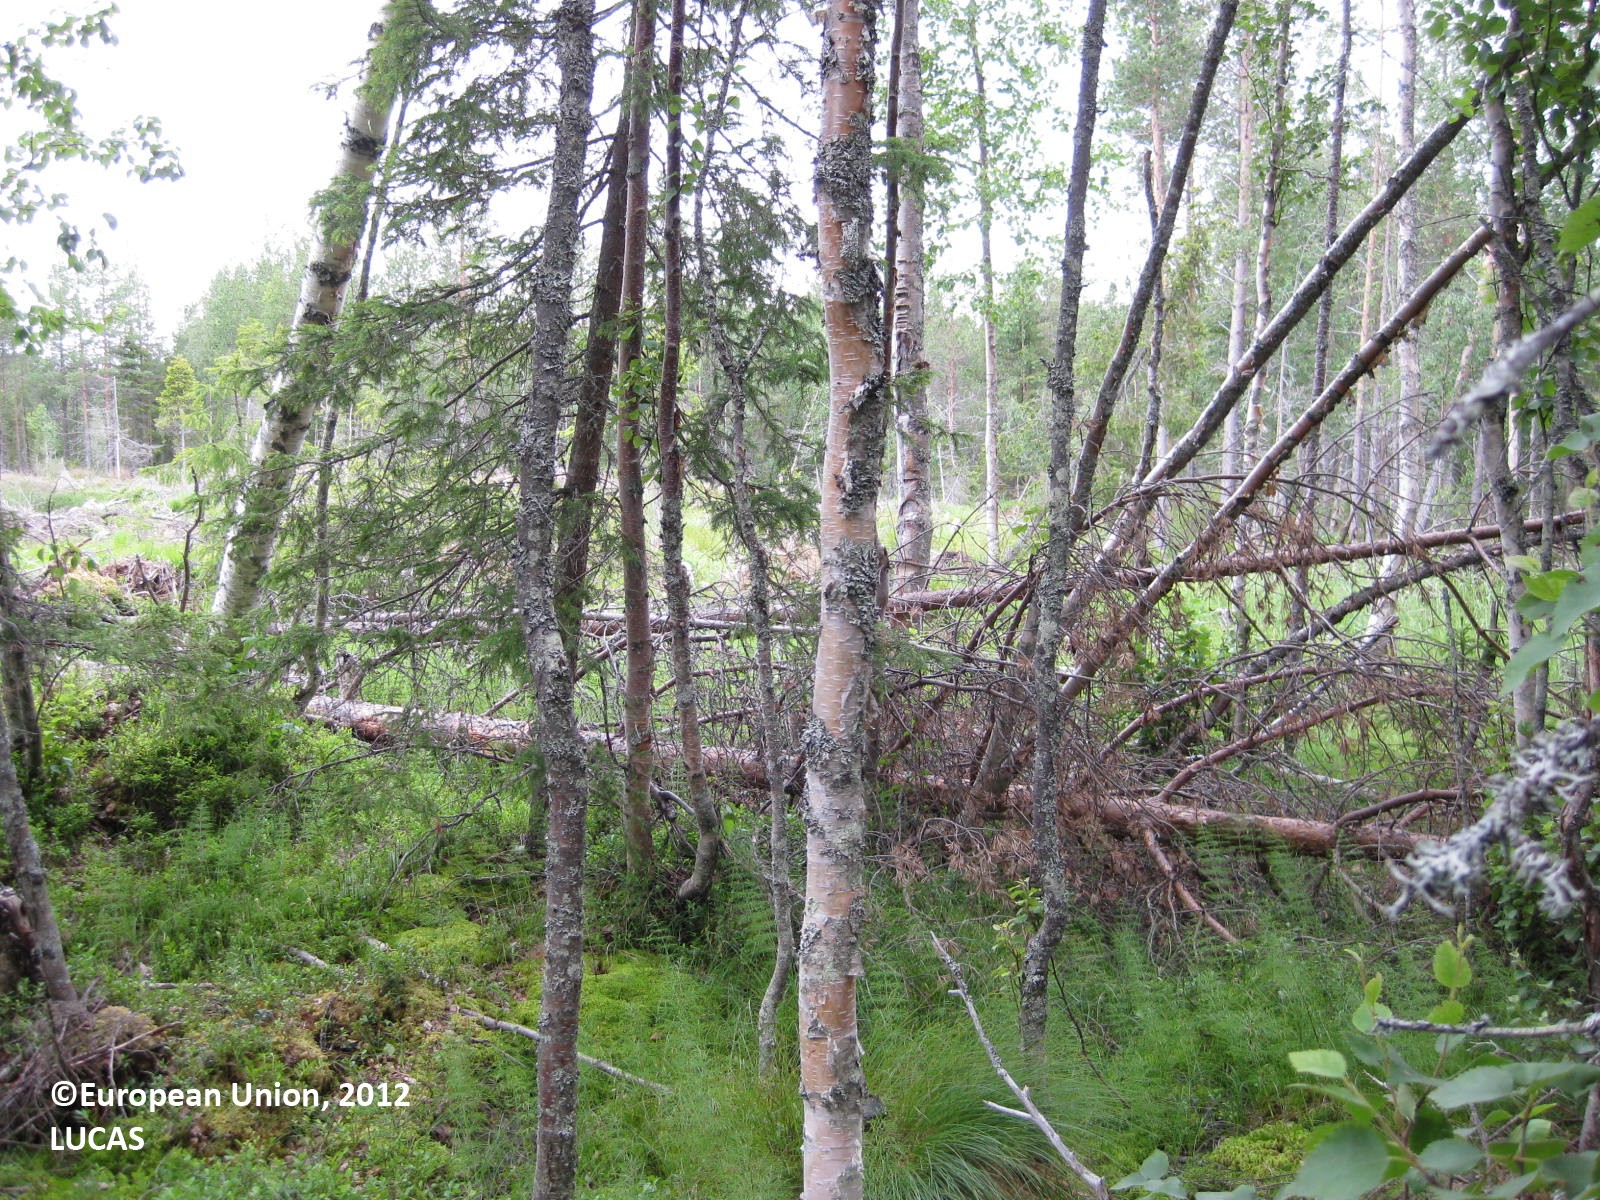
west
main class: Woodland
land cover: Pine dominated mixed woodland
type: boreal forest
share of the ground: > 75 %
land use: Forestry
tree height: > 5 m
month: July
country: FI
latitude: 65.9063
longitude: 29.6707
